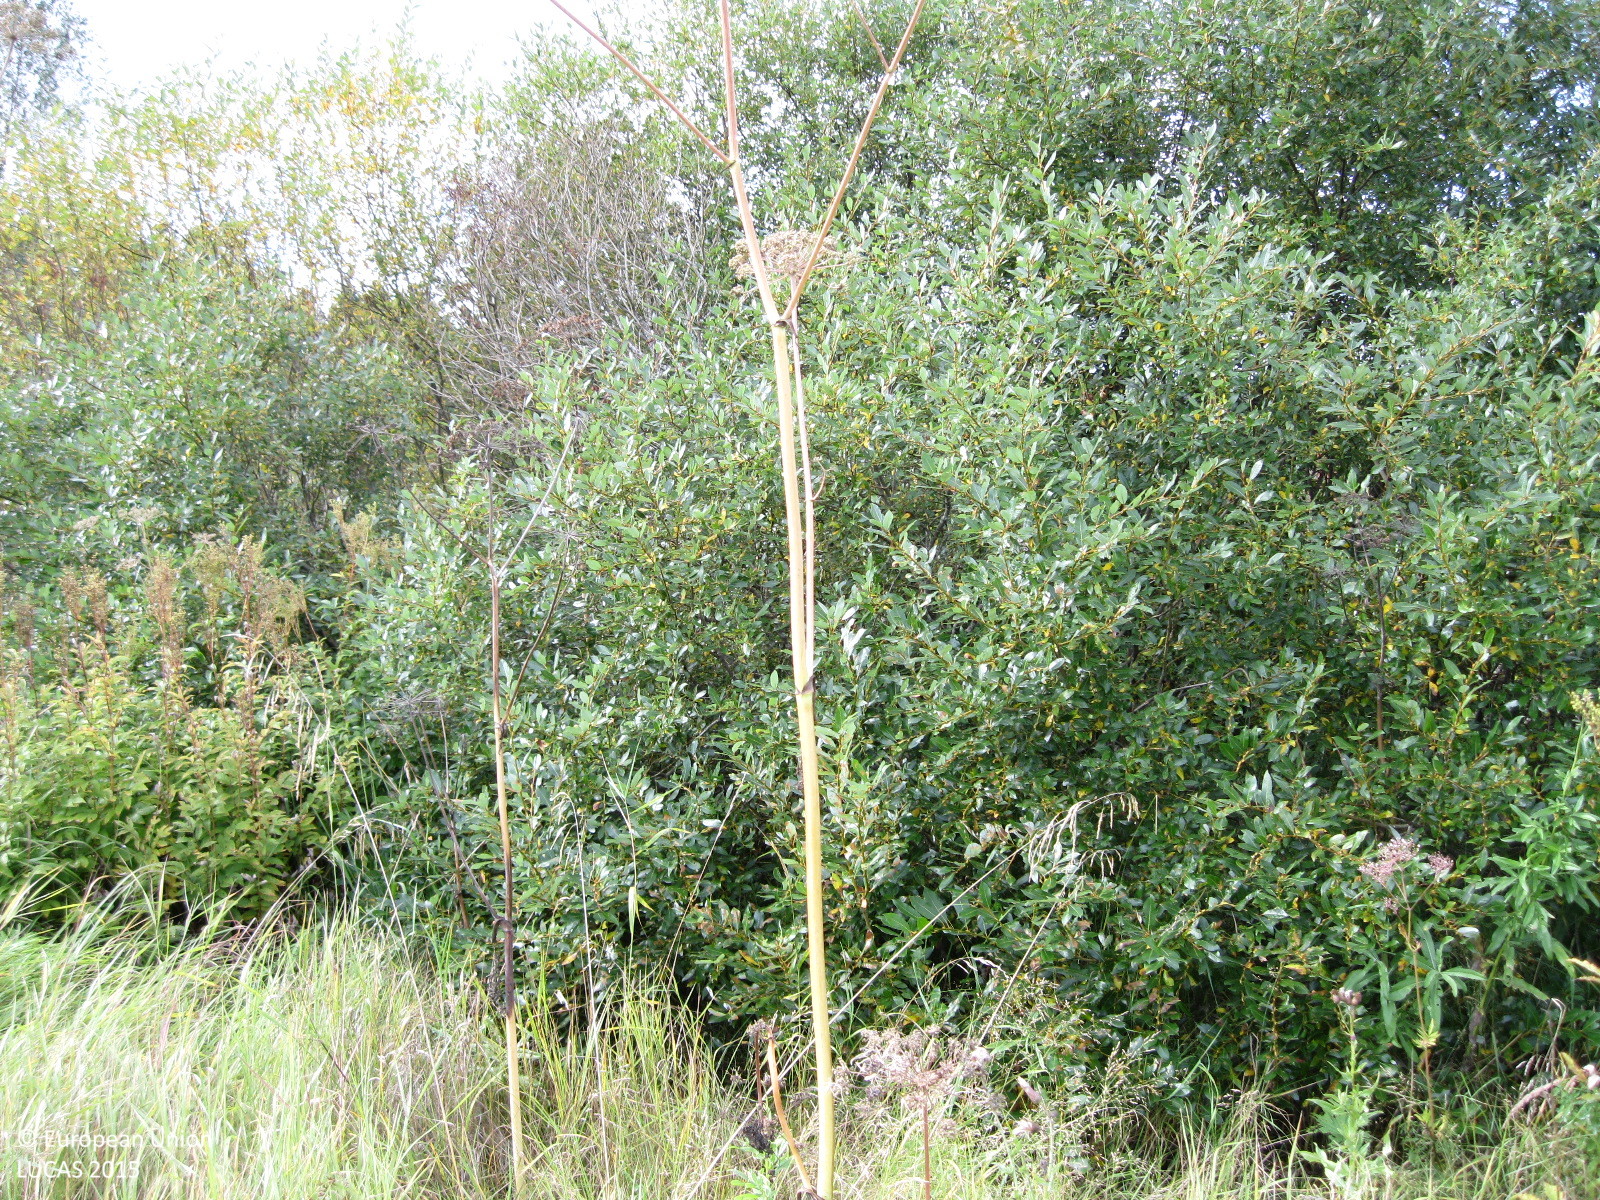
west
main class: Grassland
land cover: Grassland with sparse tree/shrub cover
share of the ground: > 75 %
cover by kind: herbaceous plants 95 %, broadleaved forest trees 5 %
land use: Residential
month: September
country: FI
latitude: 60.4741
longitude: 24.8303
